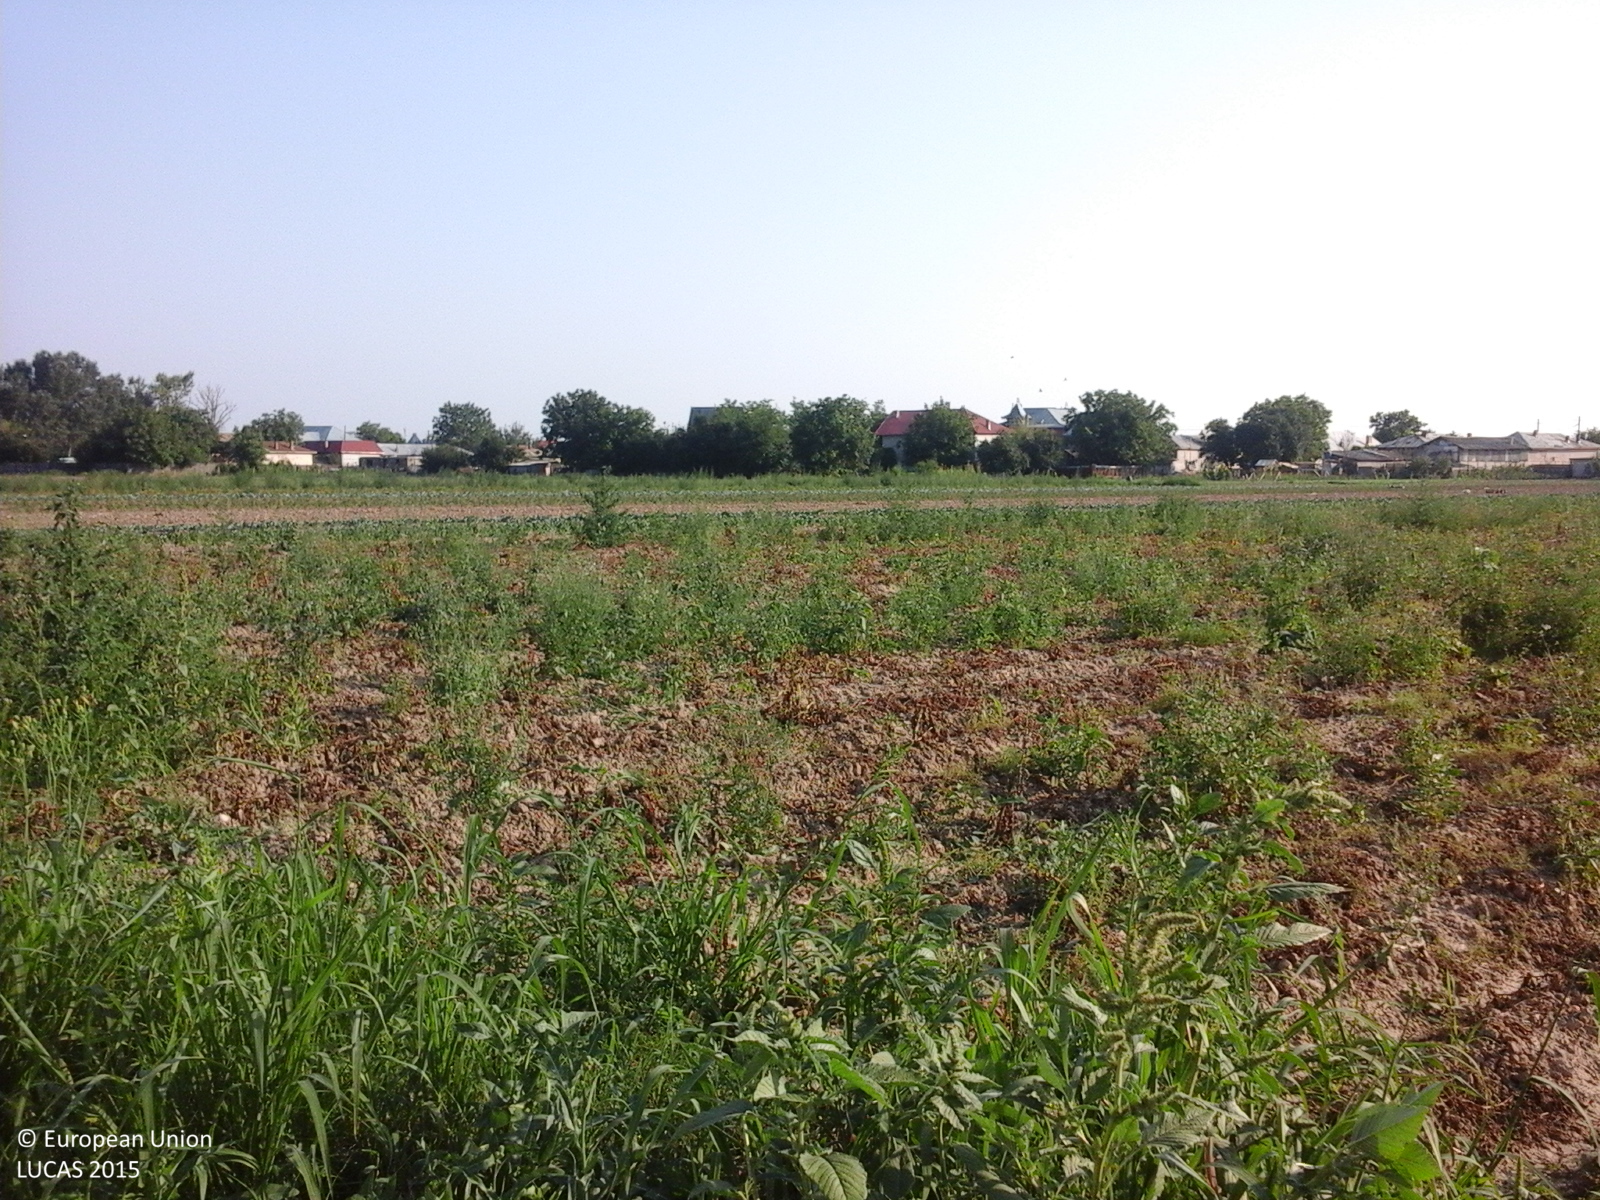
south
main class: Cropland
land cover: Potatoes
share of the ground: 50 - 75 %
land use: Agriculture (excluding fallow land and kitchen gardens)
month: July
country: RO
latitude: 44.6201
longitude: 25.6611
